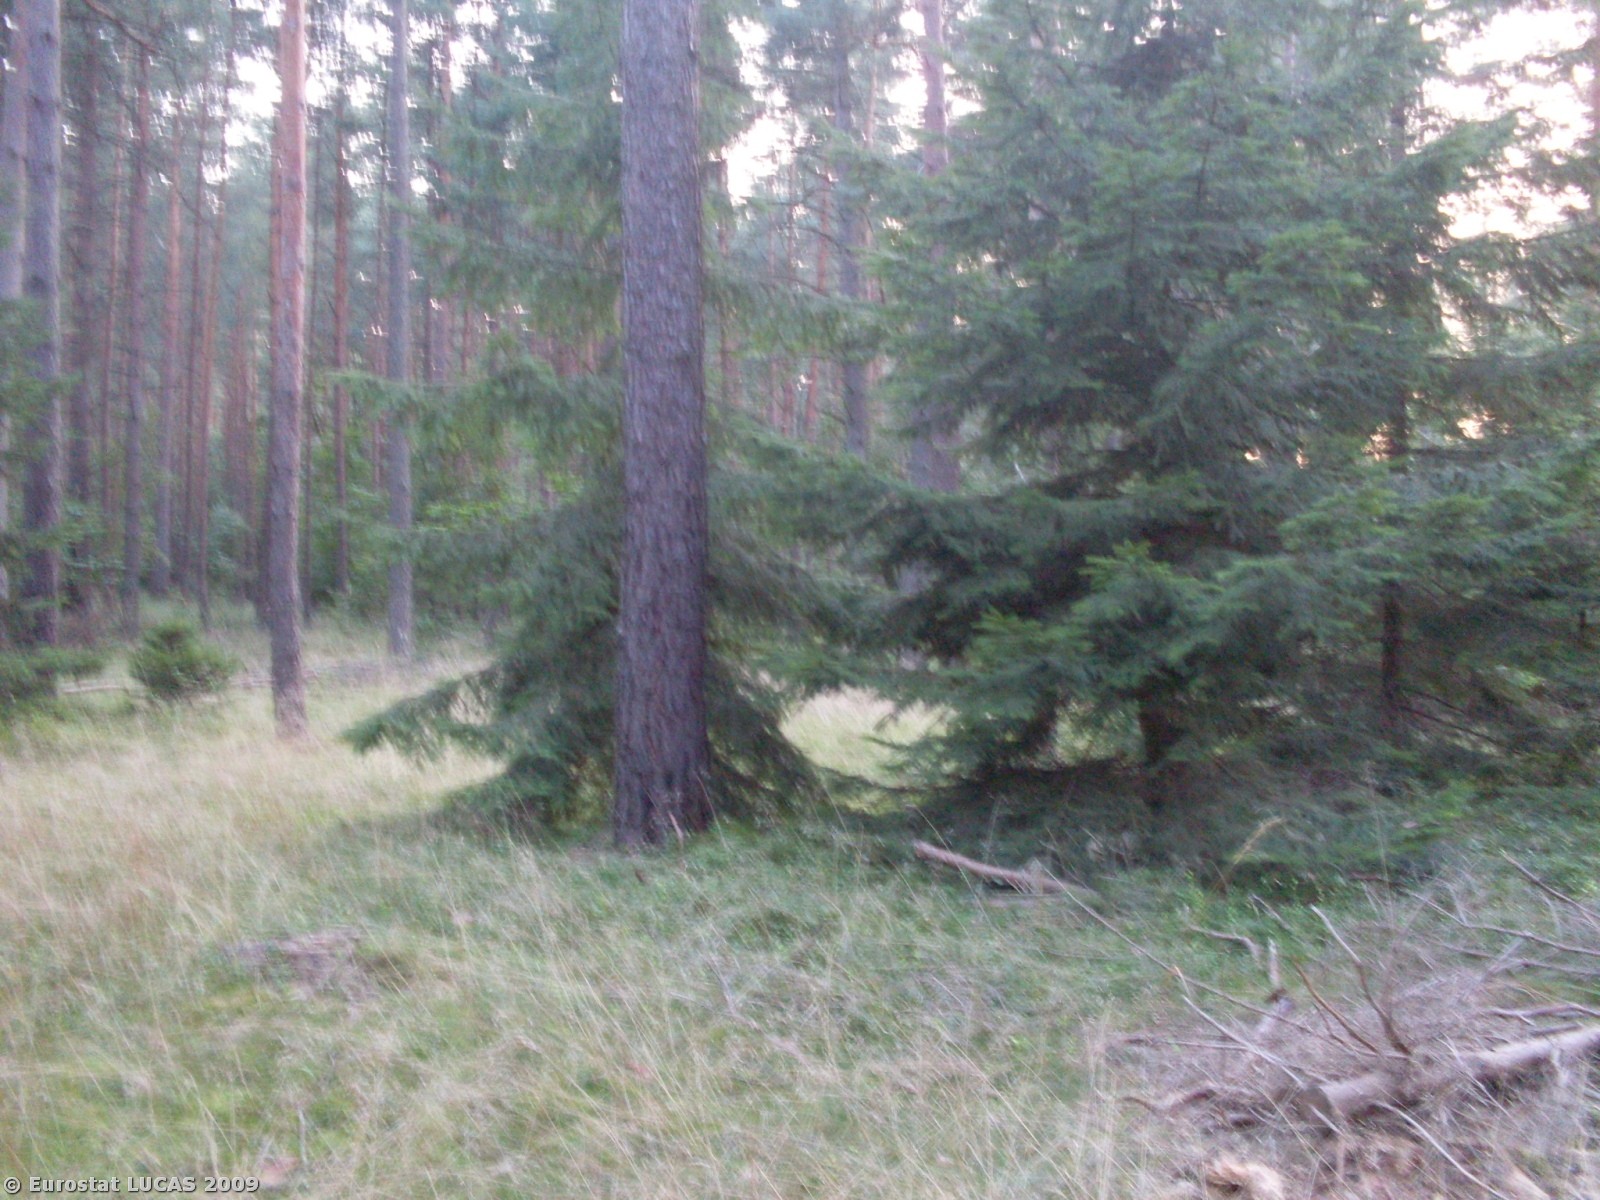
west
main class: Woodland
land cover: Mixed woodland
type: hemiboreal forest and nemoral coniferous forest and mixed broadleaved-coniferous forest
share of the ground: > 75 %
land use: Forestry
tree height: > 5 m
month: July
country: PL
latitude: 53.0048
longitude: 15.9212
